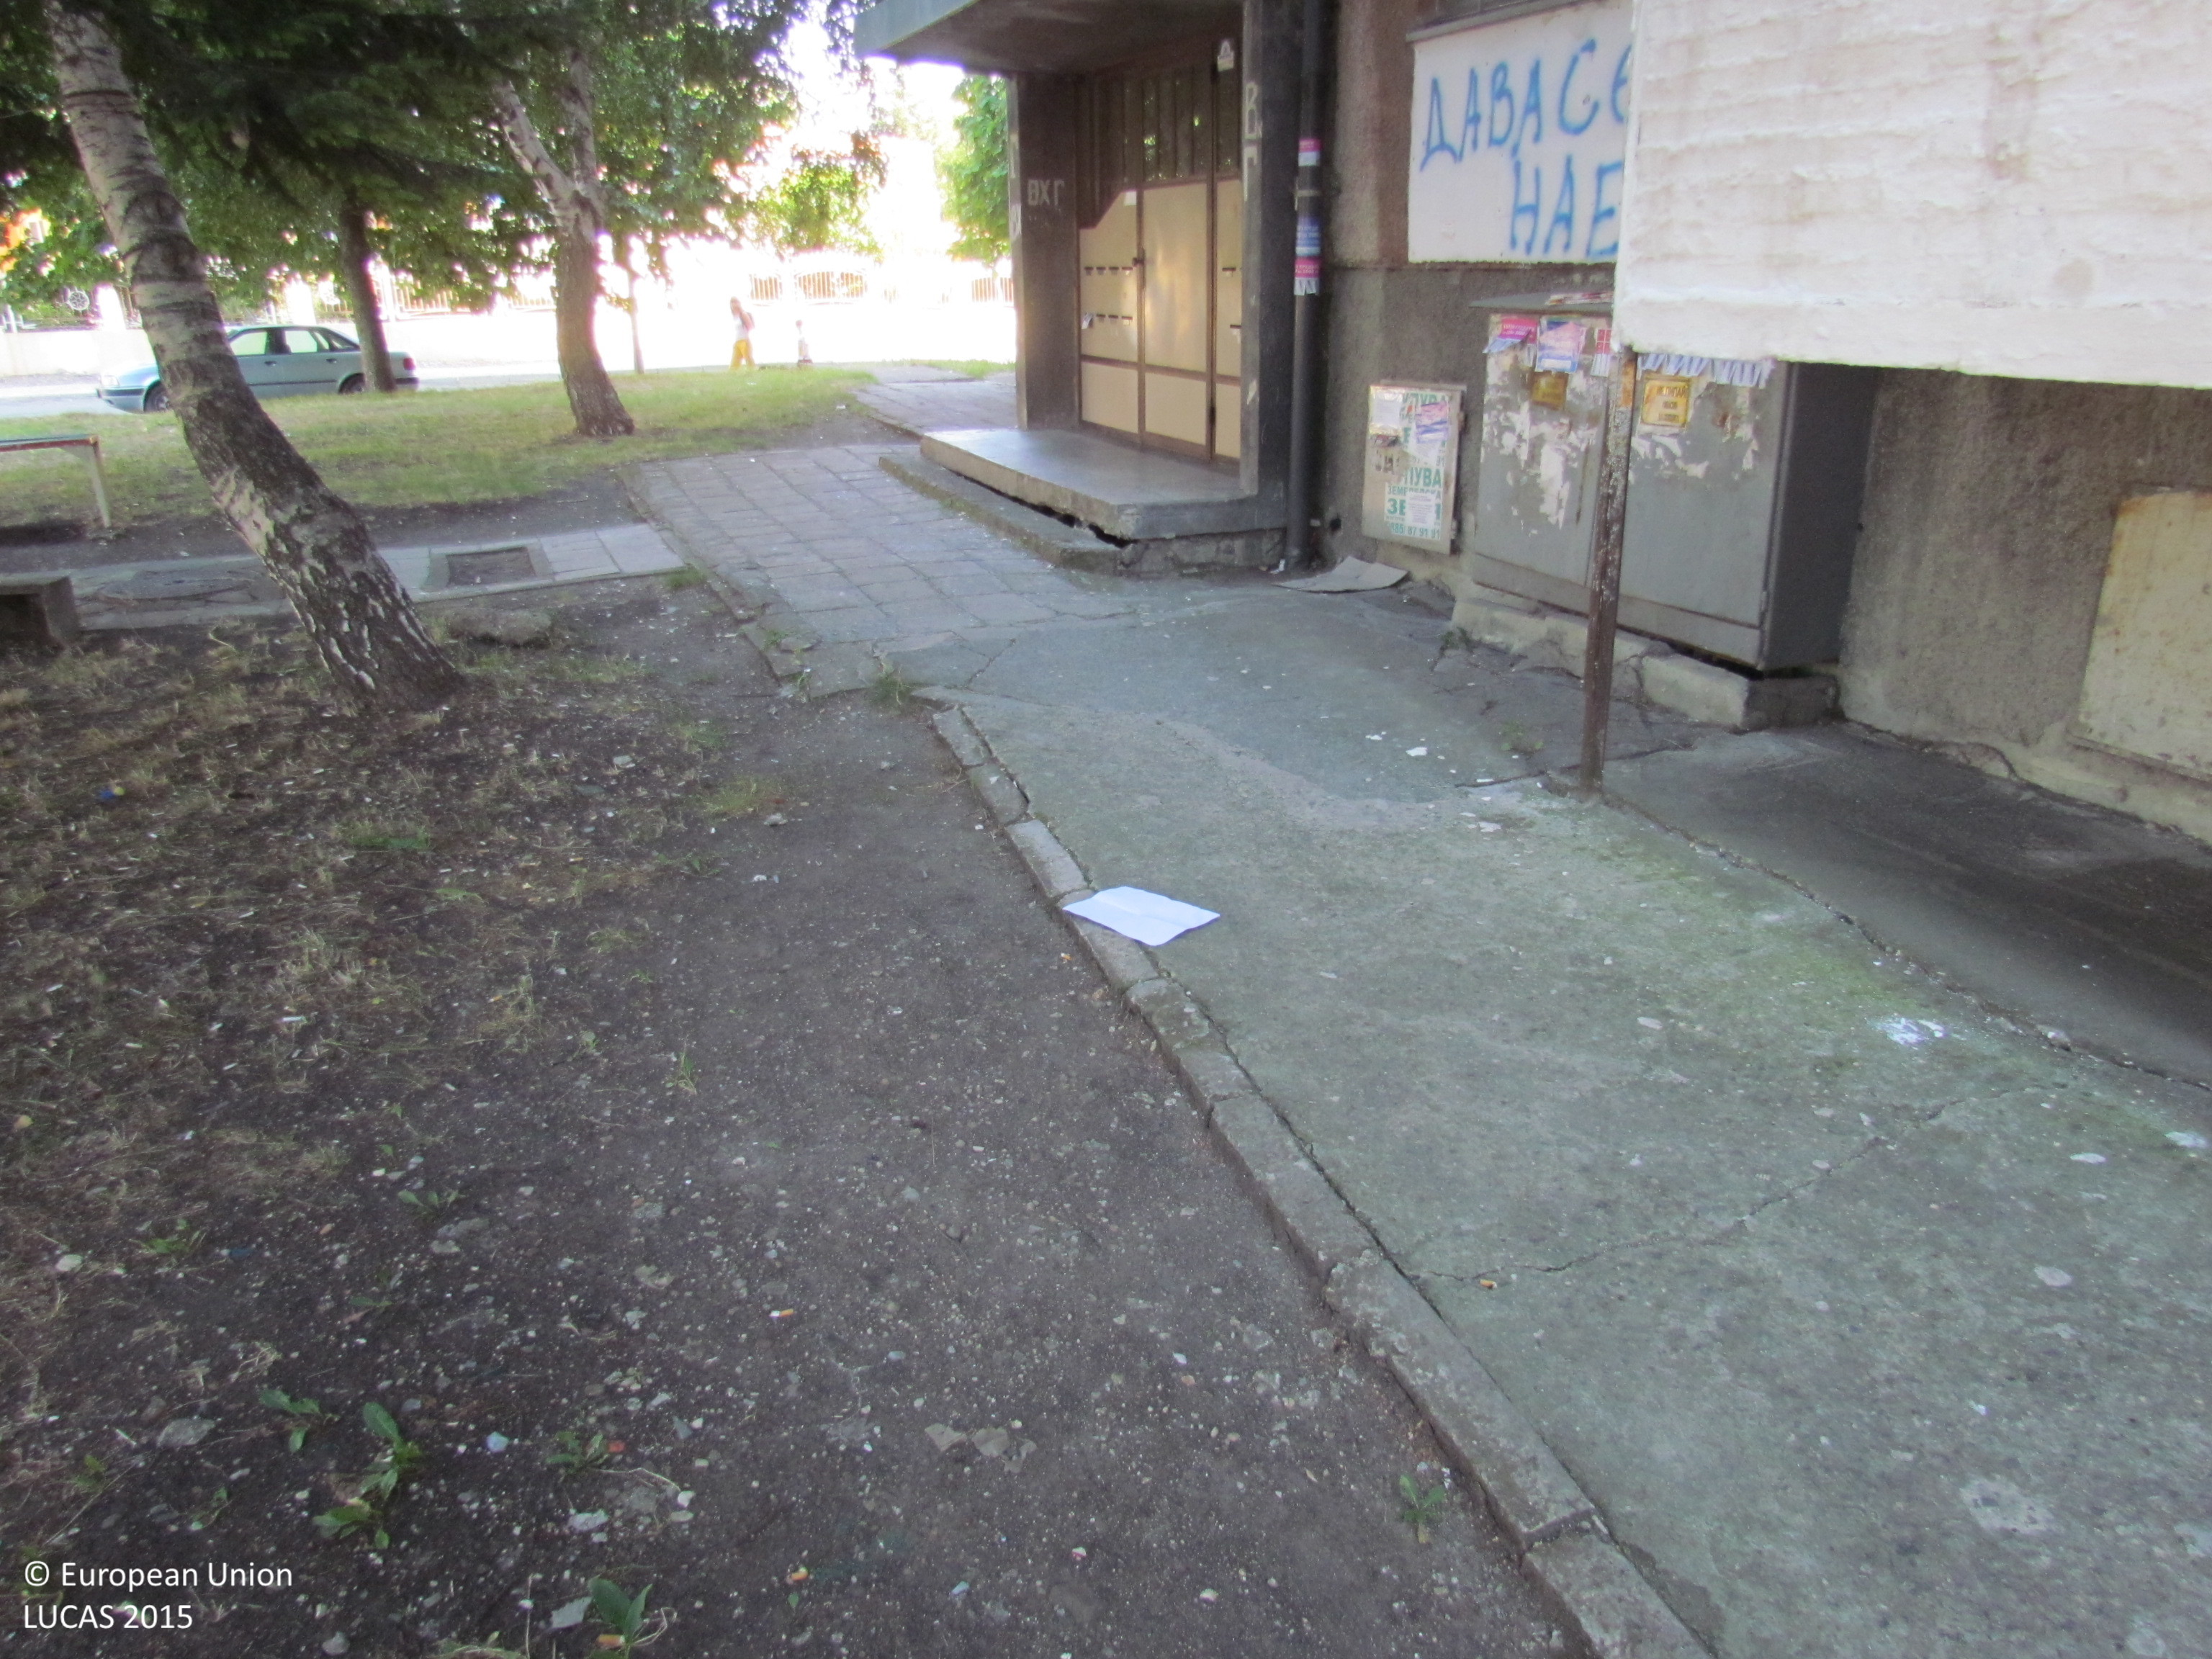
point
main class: Woodland
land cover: Broadleaved woodland
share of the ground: > 75 %
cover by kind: broadleaved forest trees 75 %, unconsolidated bare surface 15 %, herbaceous plants 10 %
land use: Residential
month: July
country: BG
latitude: 42.4579
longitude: 27.4193
